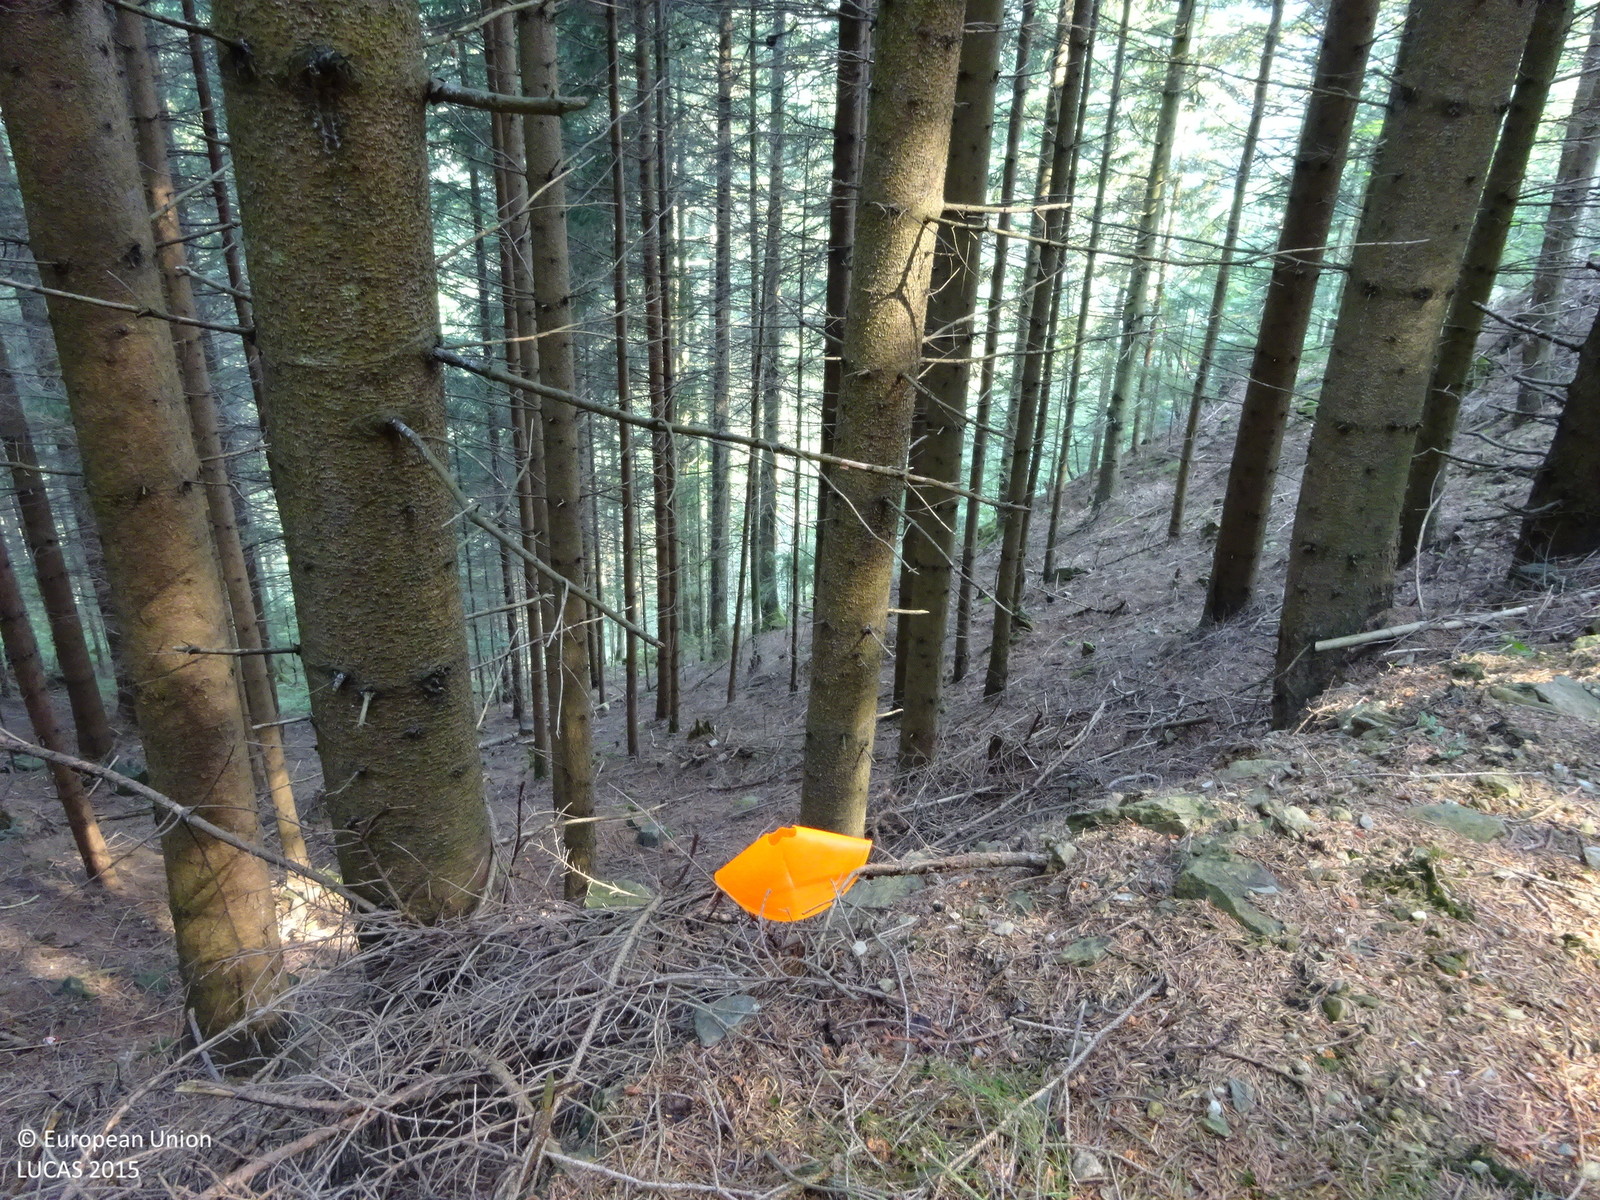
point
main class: Woodland
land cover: Spruce dominated coniferous woodland
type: alpine coniferous forest
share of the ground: > 75 %
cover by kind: coniferous forest trees 95 %, unconsolidated bare surface 5 %
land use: Forestry
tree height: > 5 m
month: August
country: AT
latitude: 47.3899
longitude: 15.7109
